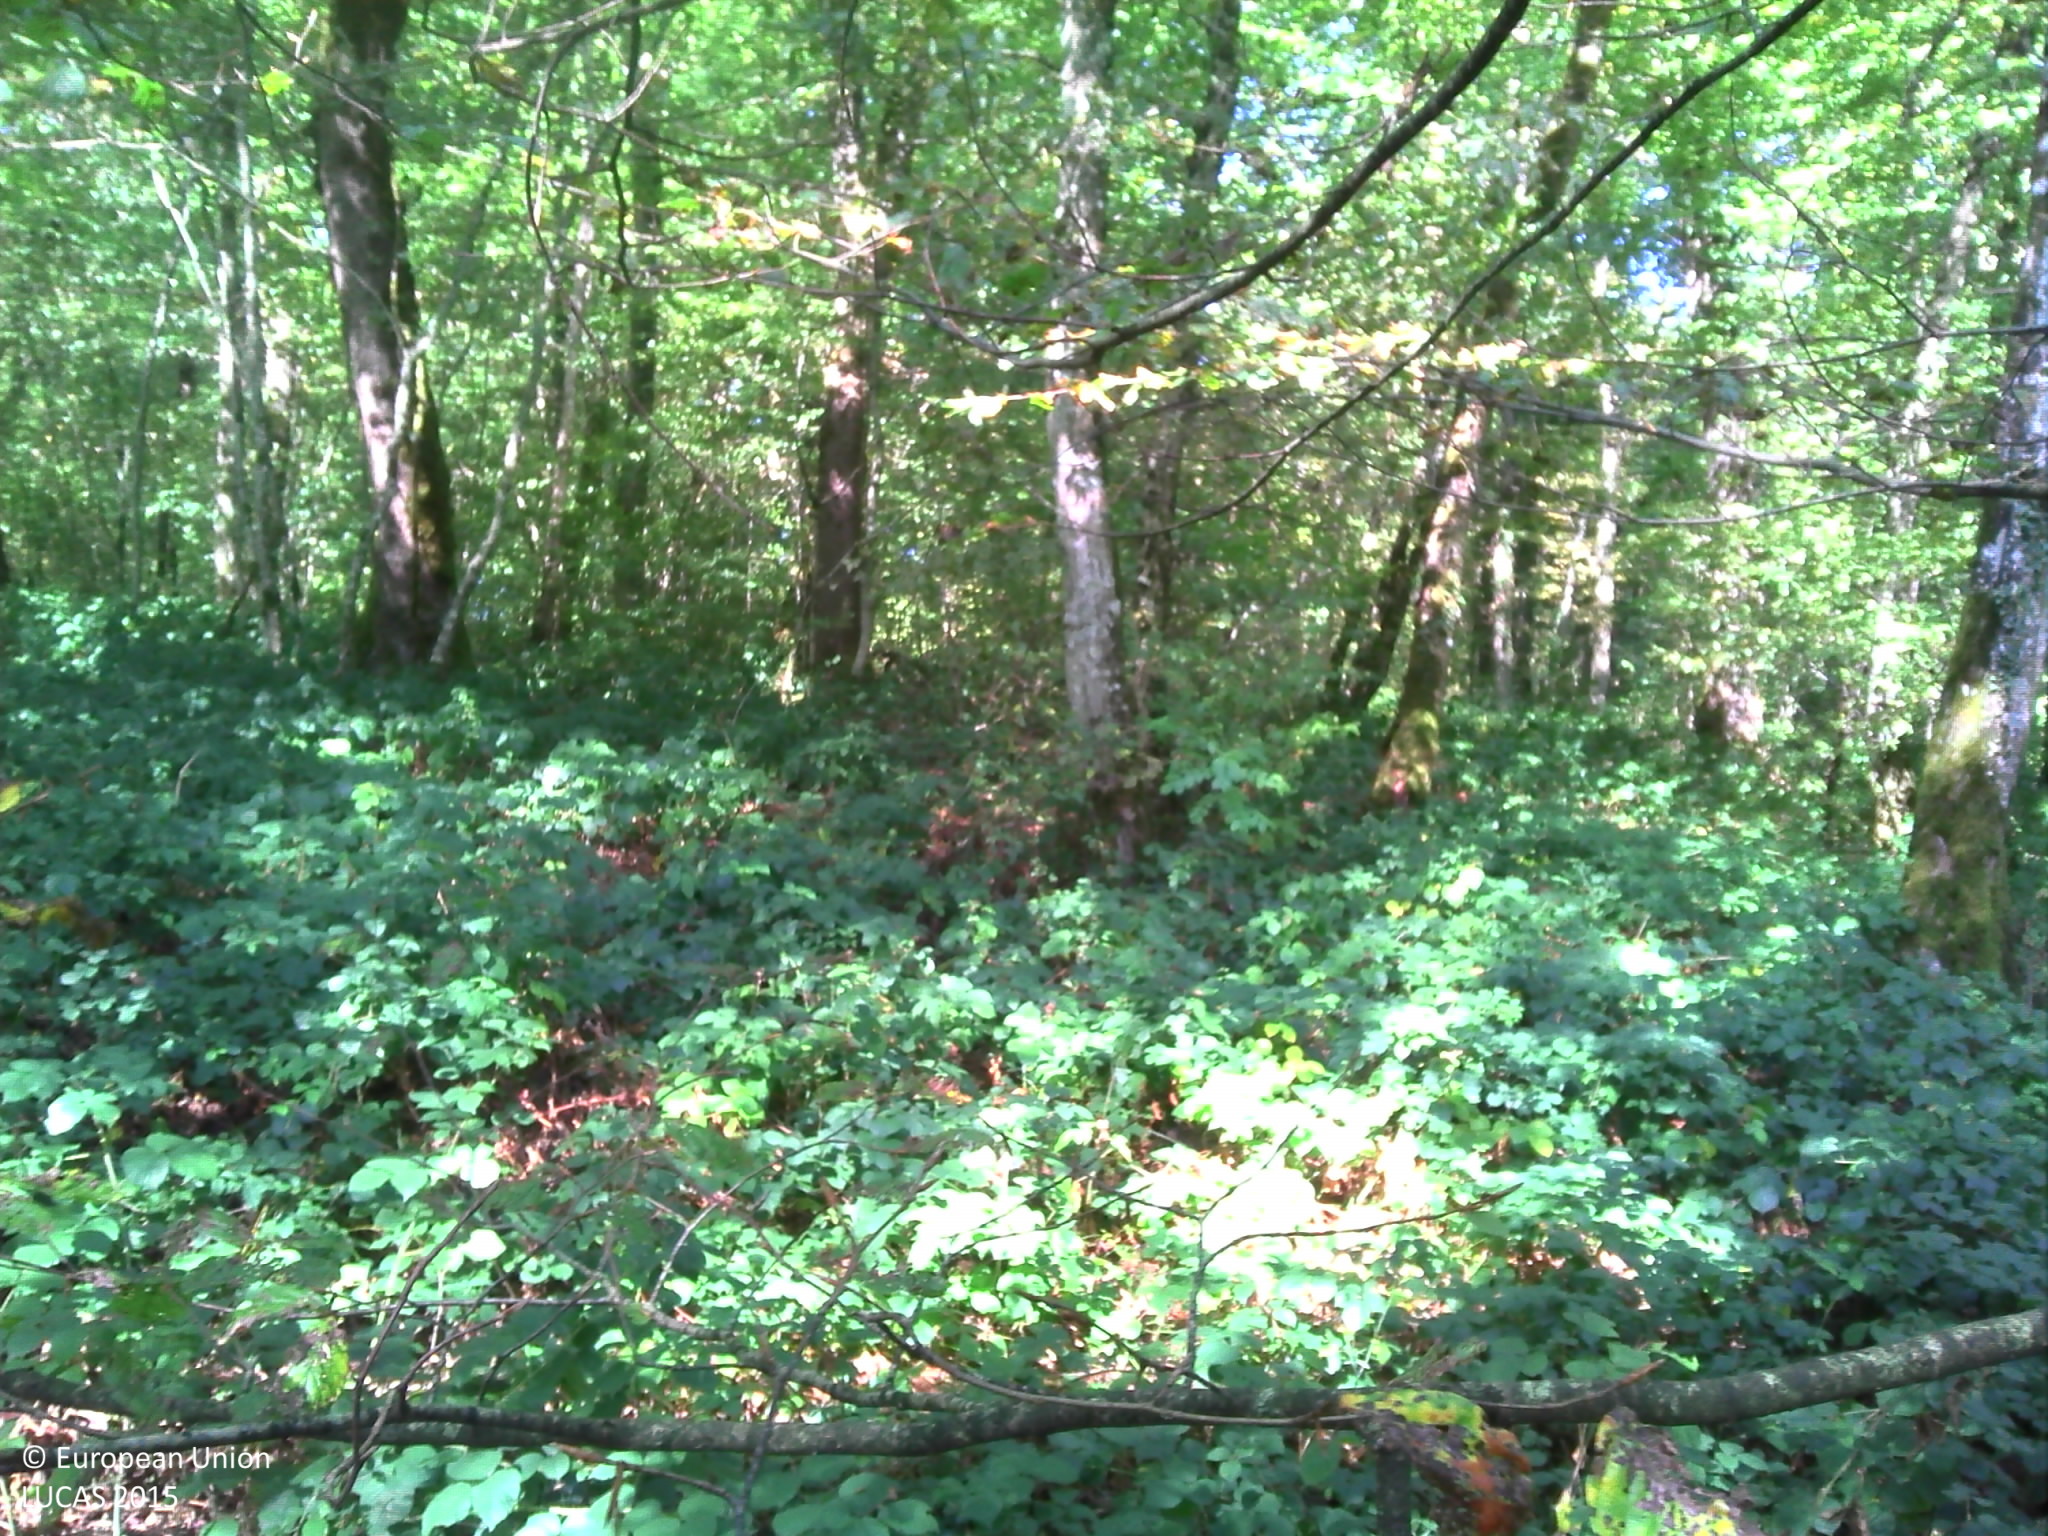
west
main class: Woodland
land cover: Broadleaved woodland
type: beech forest
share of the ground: > 75 %
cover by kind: broadleaved forest trees 100 %
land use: Forestry
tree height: > 5 m
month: September
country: FR
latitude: 47.3879
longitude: 6.3322
